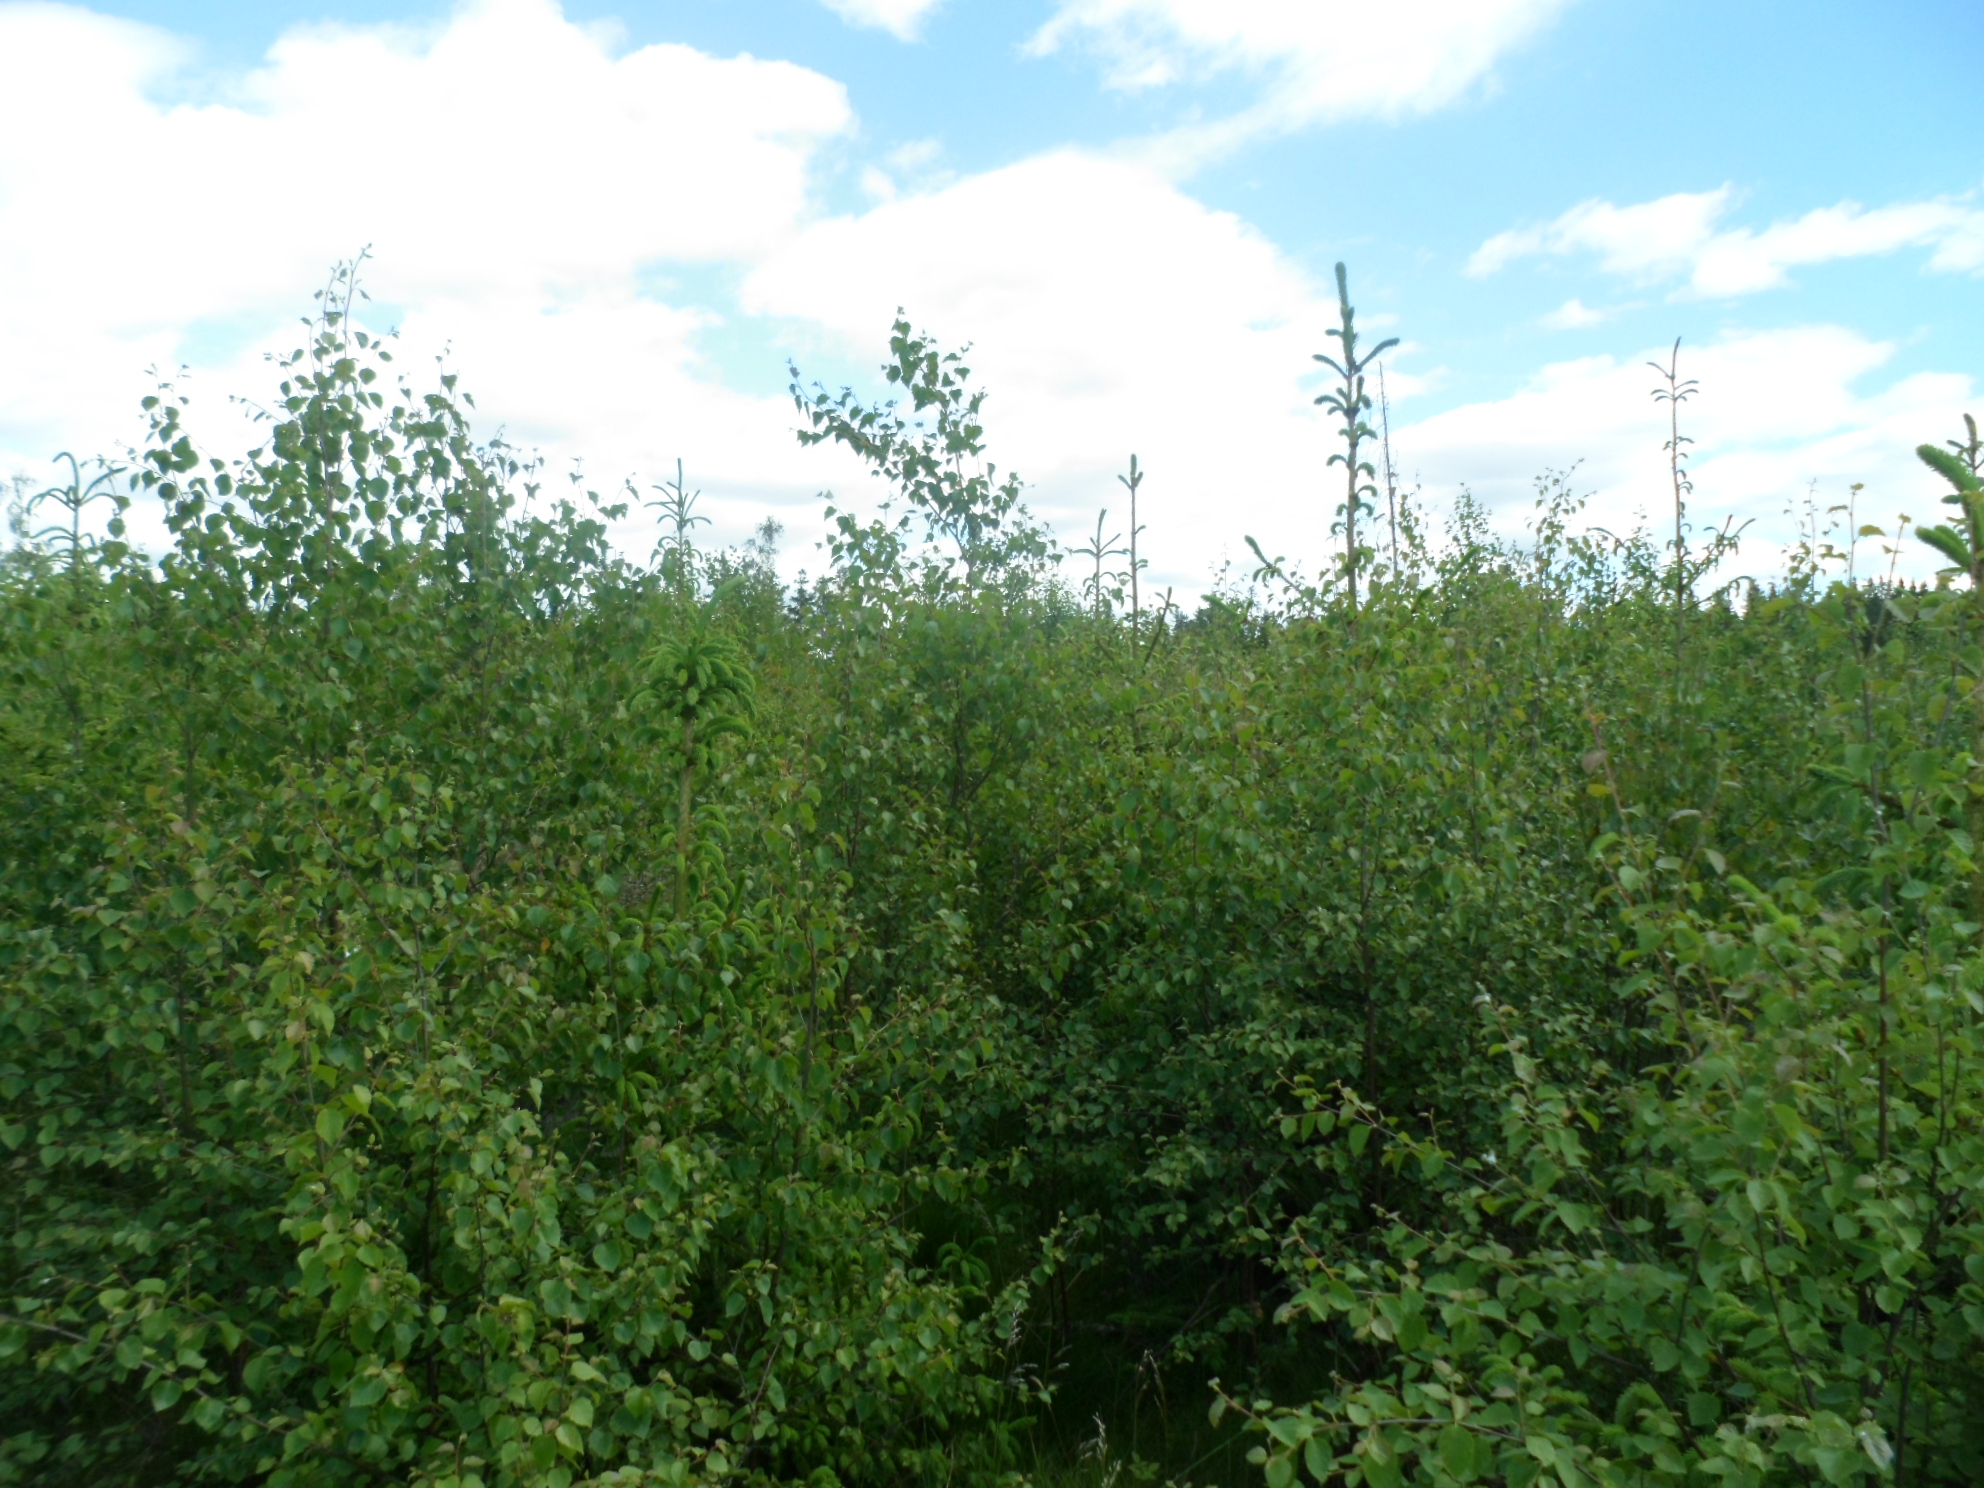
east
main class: Woodland
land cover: Spruce dominated mixed woodland
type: boreal forest
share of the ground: > 75 %
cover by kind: broadleaved forest trees 45 %, coniferous forest trees 35 %, herbaceous plants 15 %, shrubs 5 %
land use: Forestry
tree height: < 5 m
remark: Clear cut
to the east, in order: Spruce dominated mixed woodland; Spruce dominated coniferous woodland; Spruce dominated mixed woodland; Tracks; Spruce dominated mixed woodland; Ditches and canals; Spruce dominated coniferous woodland; Ditches and canals; Spruce dominated mixed woodland
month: July
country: SE
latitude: 57.4267
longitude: 14.4090
